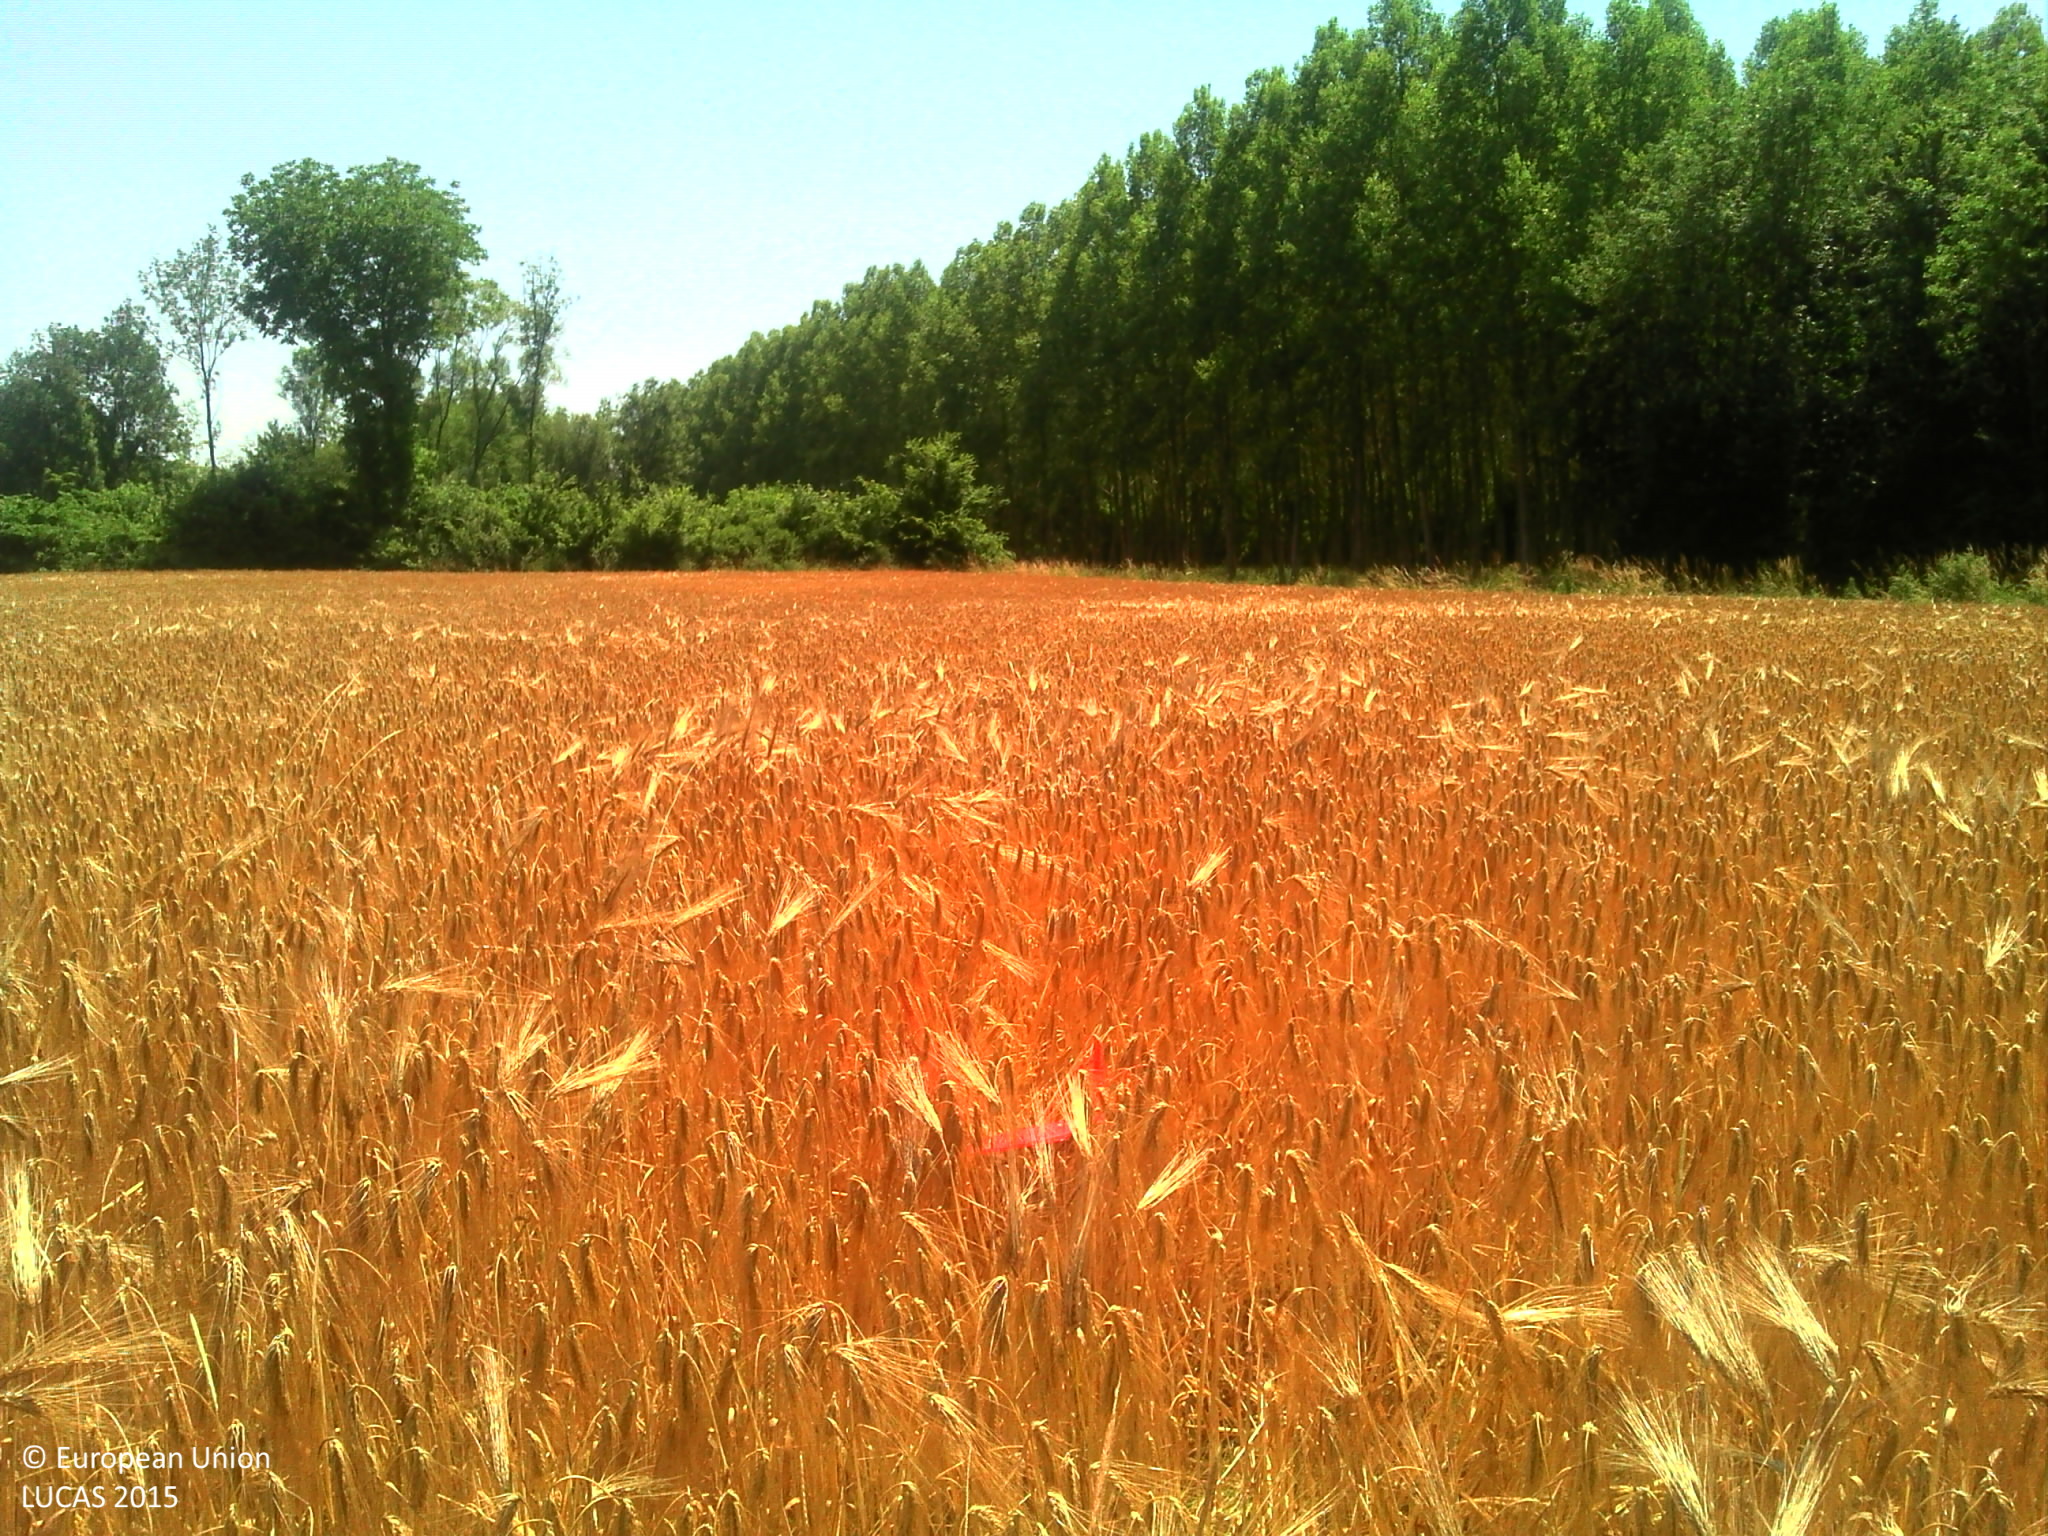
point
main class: Cropland
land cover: Barley
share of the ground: > 75 %
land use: Agriculture (excluding fallow land and kitchen gardens)
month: June
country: FR
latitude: 47.1136
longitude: 5.2963
